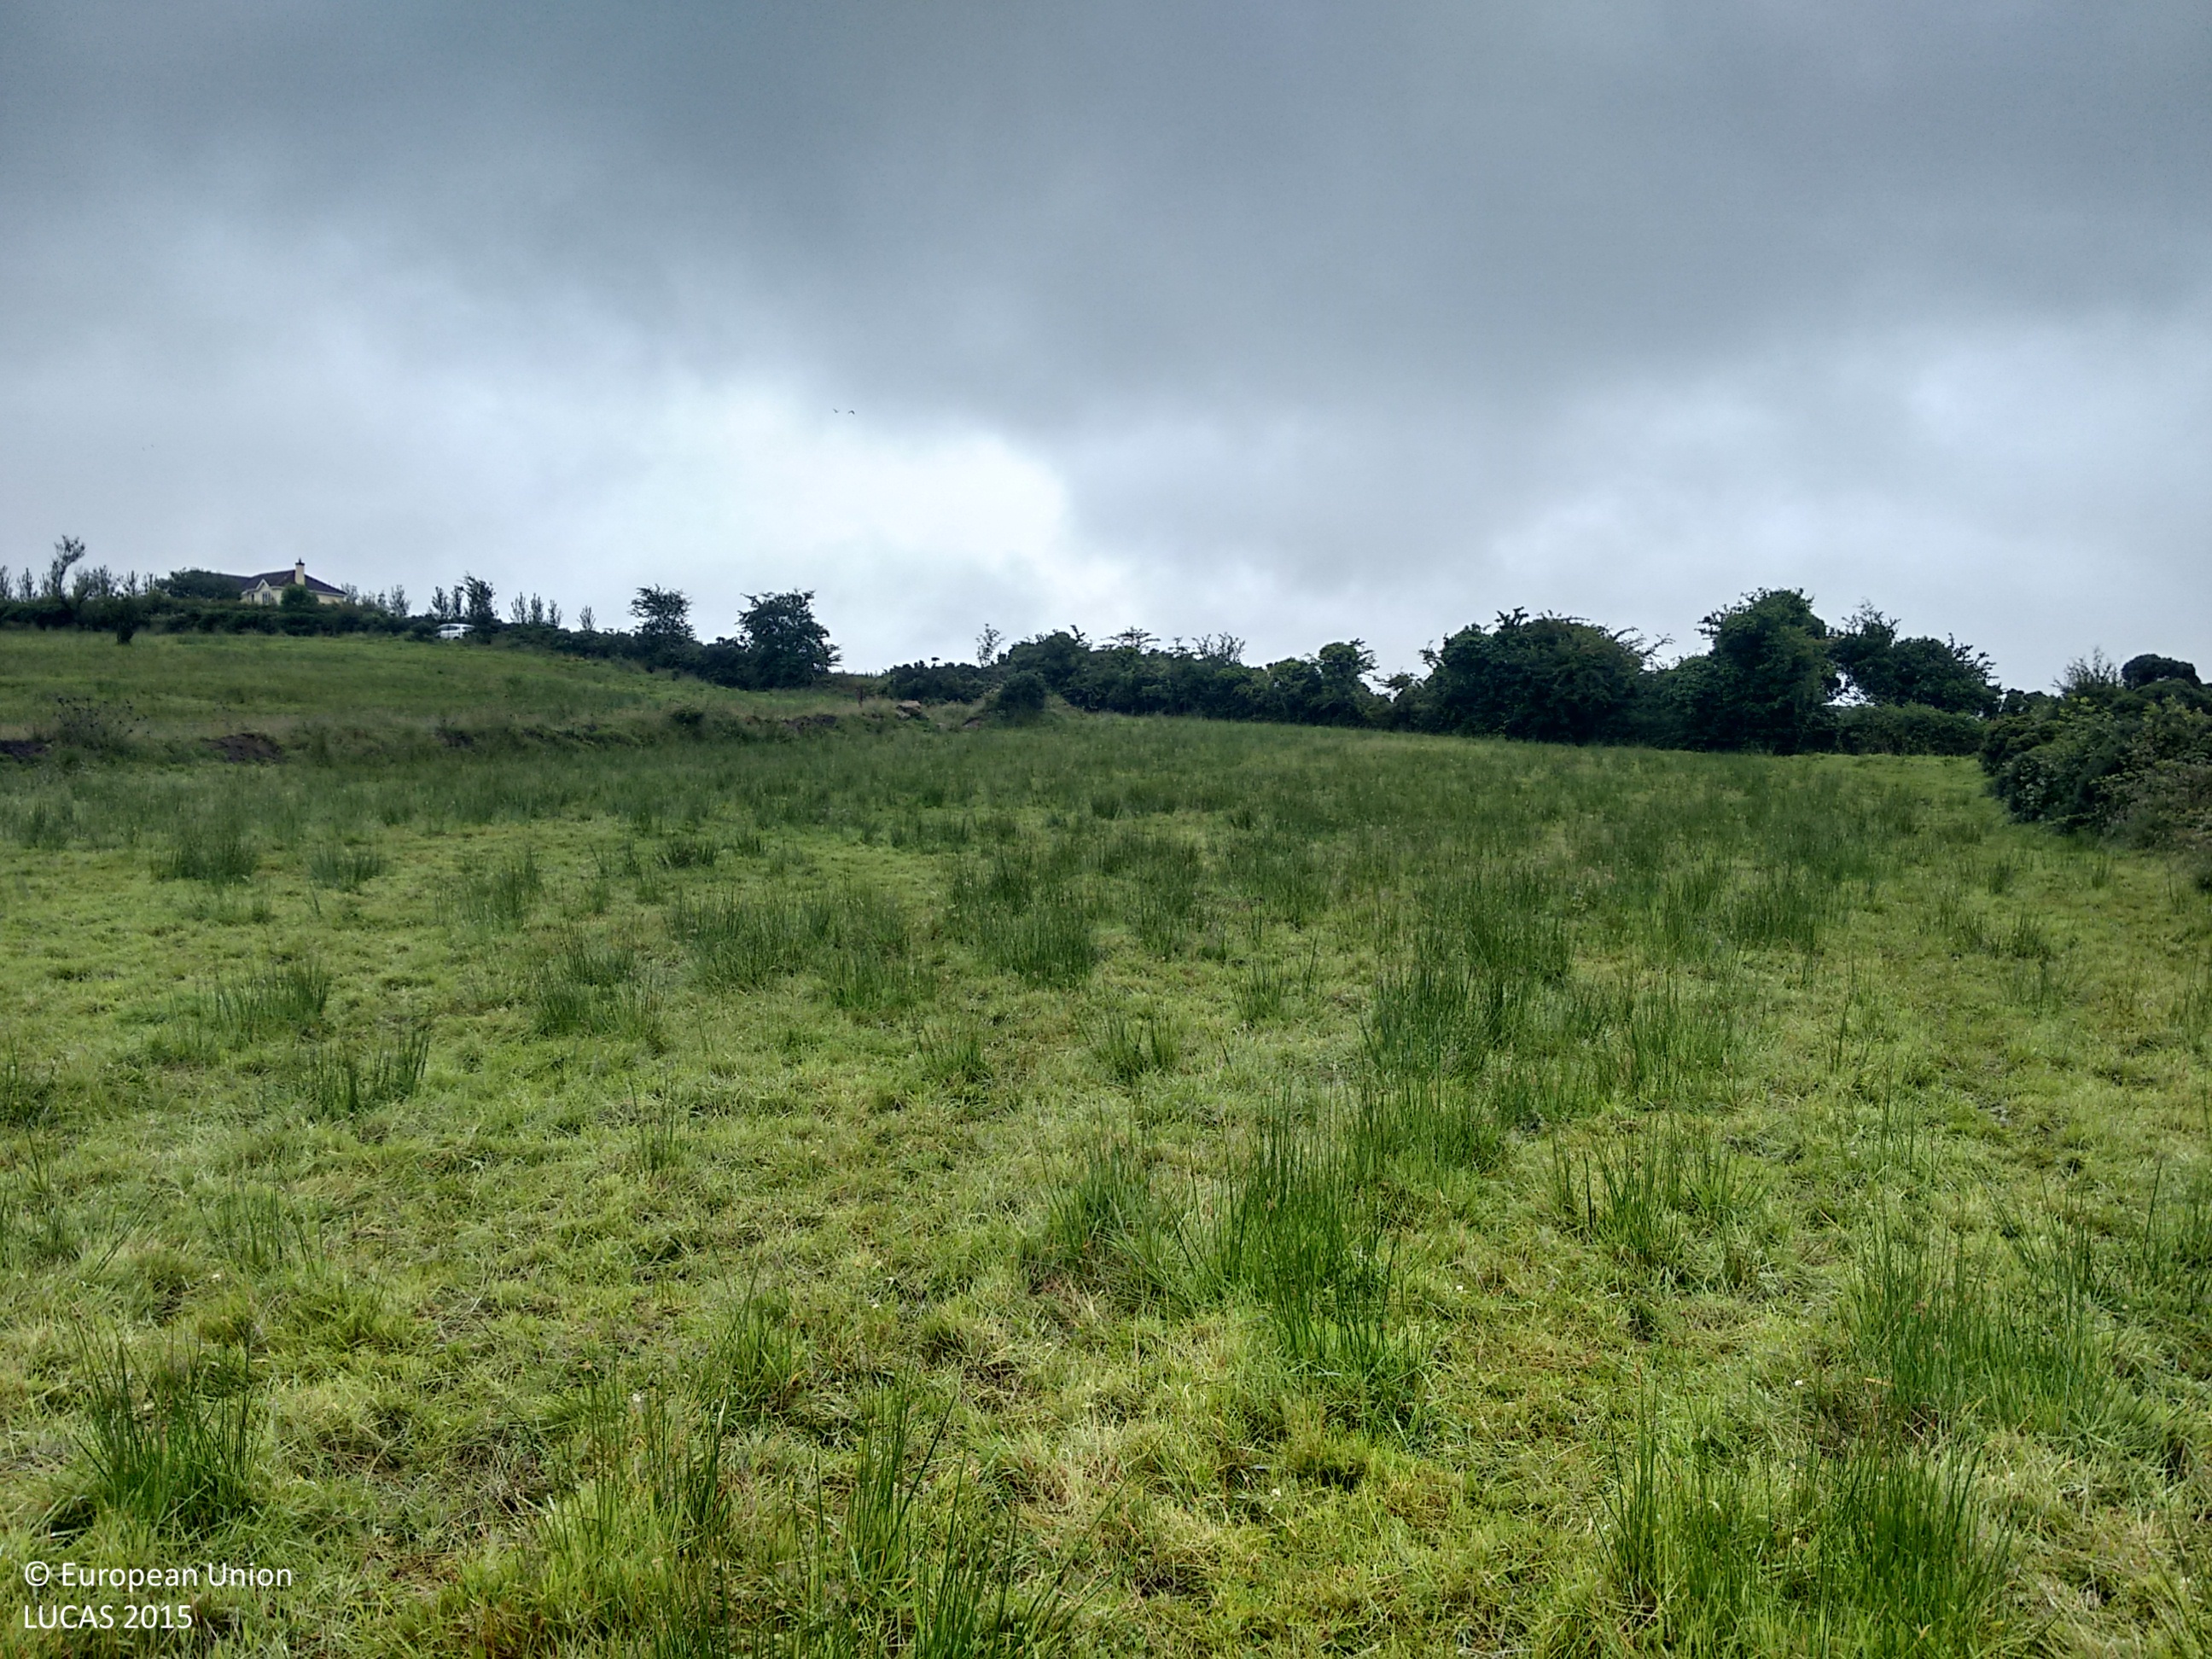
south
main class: Grassland
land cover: Grassland without tree/shrub cover
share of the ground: > 75 %
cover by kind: herbaceous plants 100 %
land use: Agriculture (excluding fallow land and kitchen gardens)
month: July
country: IE
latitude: 53.6630
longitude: -7.7358
